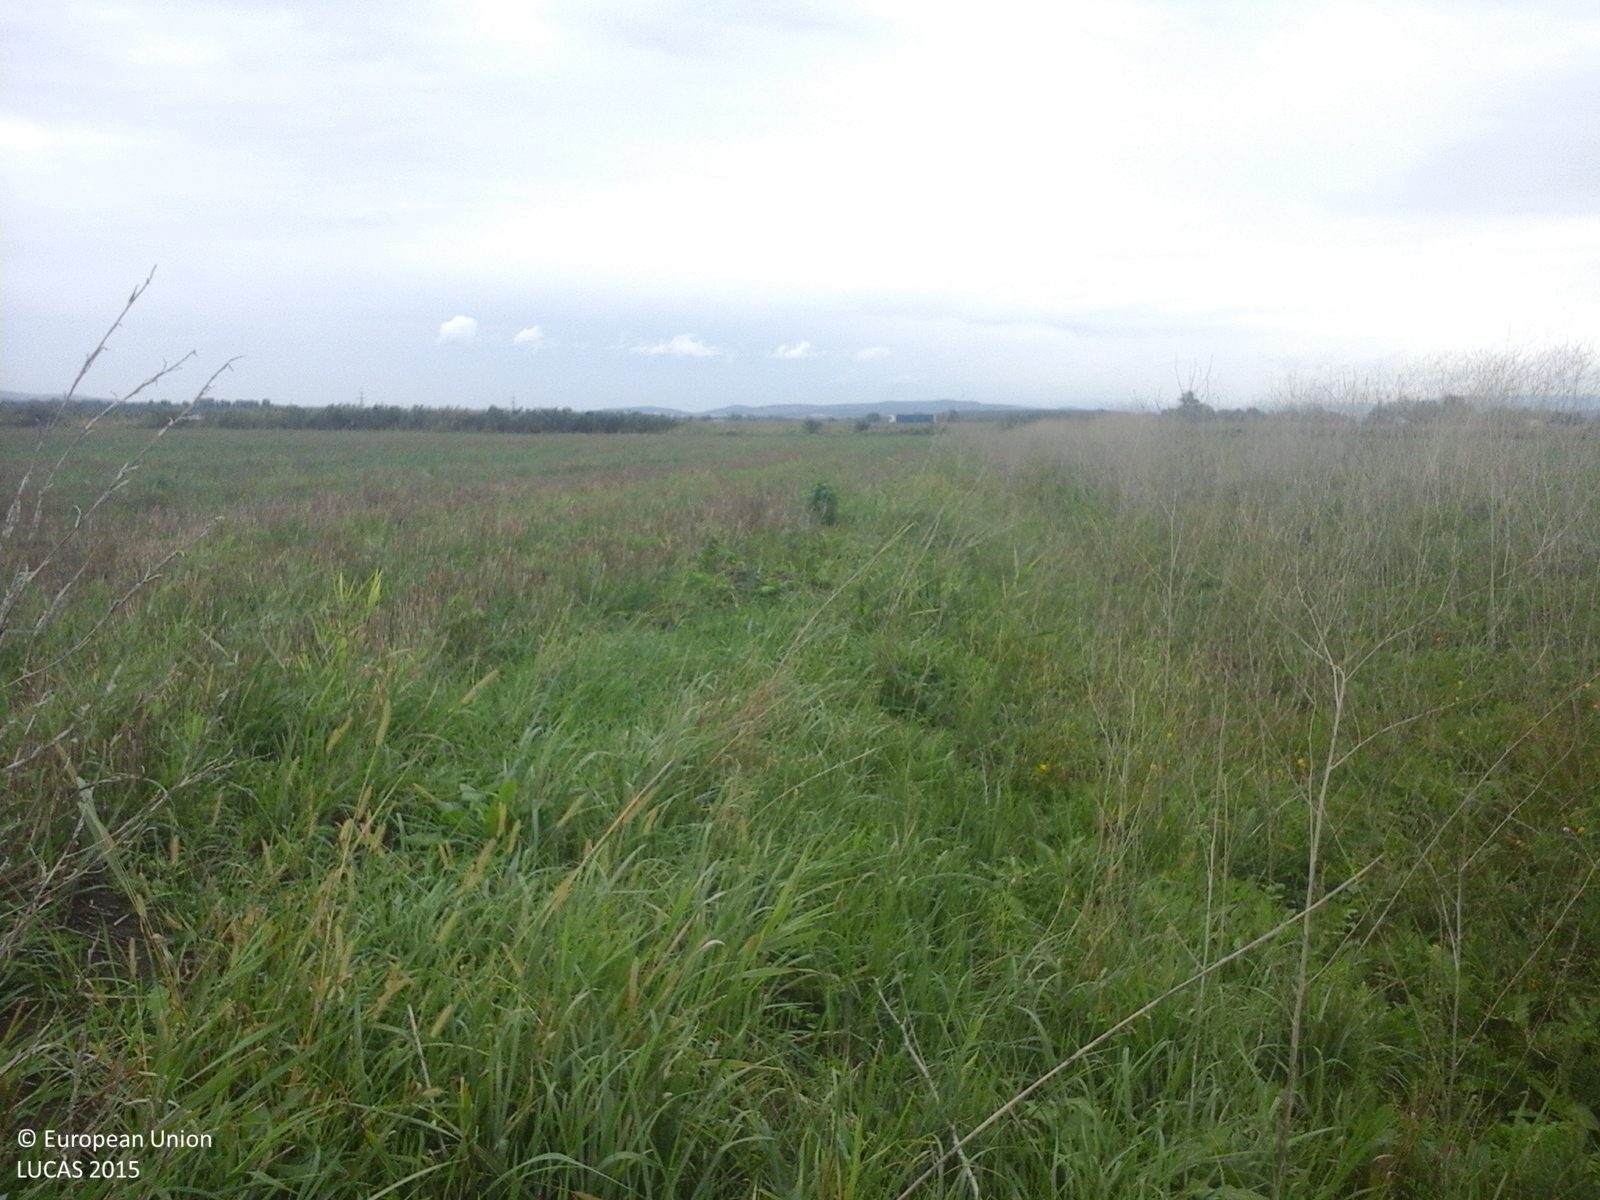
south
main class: Grassland
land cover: Spontaneously vegetated surfaces
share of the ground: > 75 %
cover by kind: herbaceous plants 100 %
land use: Fallow land
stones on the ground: < 10 %
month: September
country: RO
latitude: 45.8815
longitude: 23.0049
